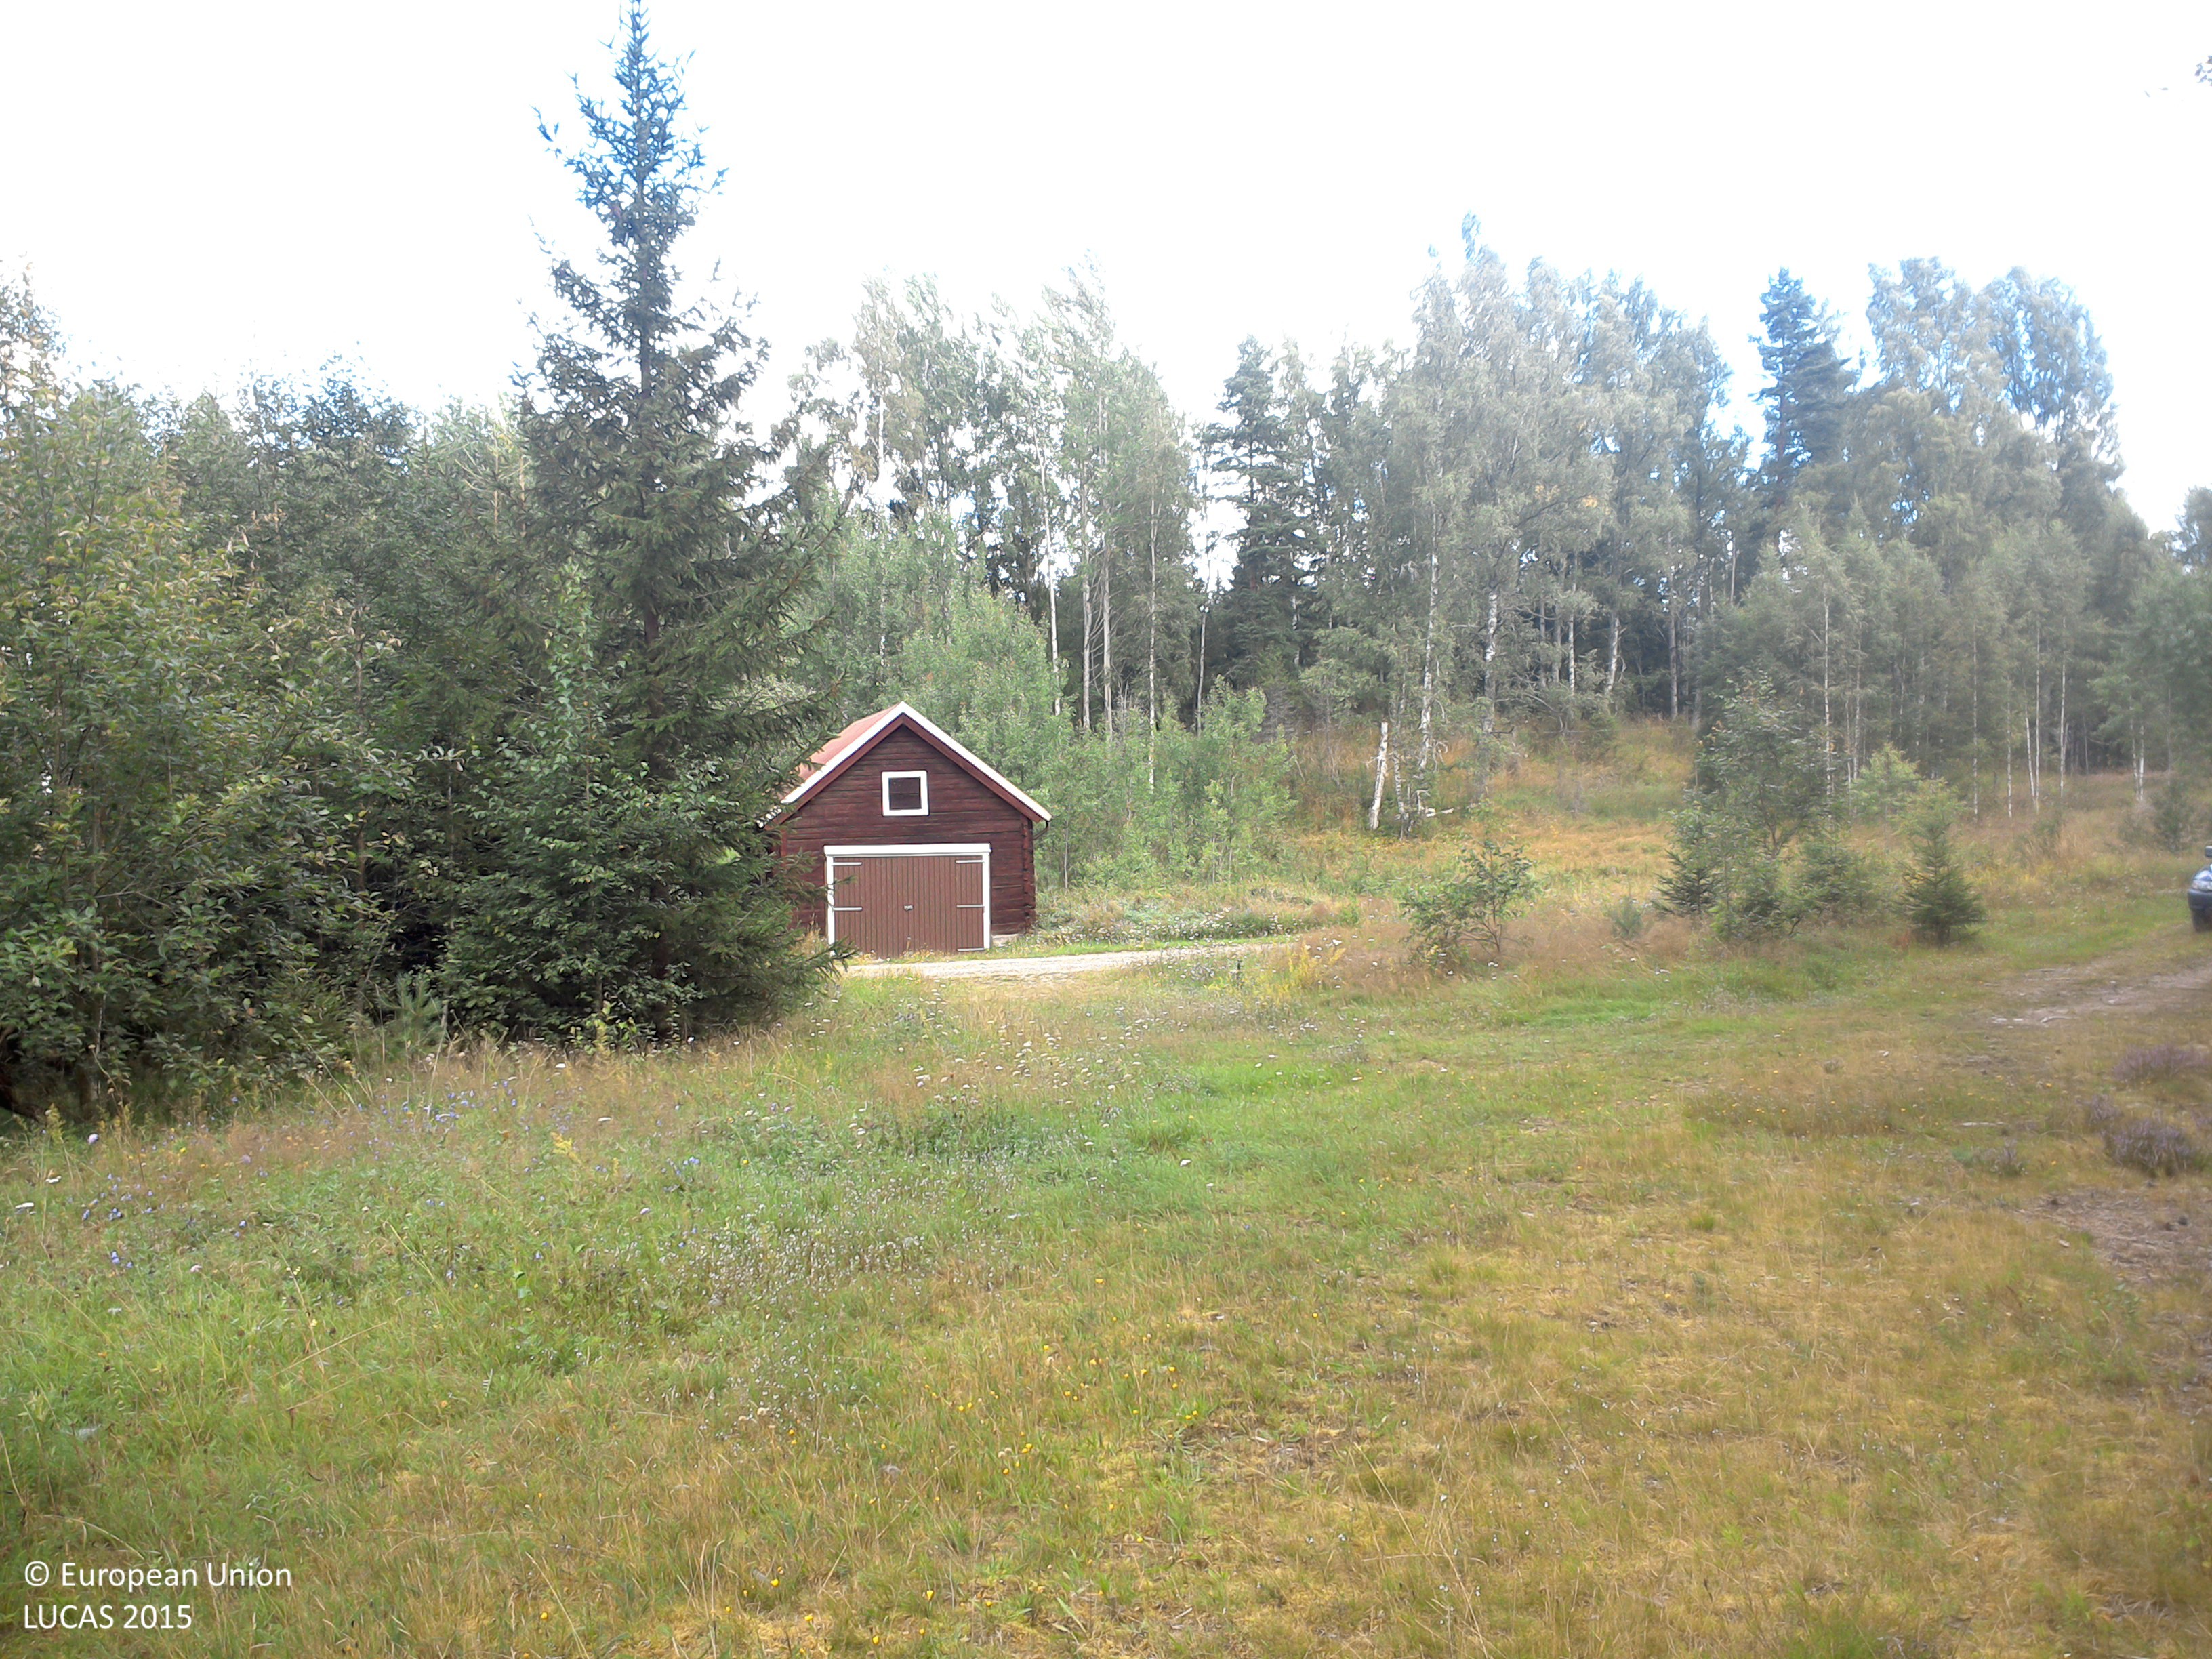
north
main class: Grassland
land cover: Grassland with sparse tree/shrub cover
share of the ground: > 75 %
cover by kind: herbaceous plants 90 %, coniferous forest trees 5 %, lichens and mosses 5 %
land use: Residential
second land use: Logistics and storage
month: August
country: SE
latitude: 57.8294
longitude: 15.6711
